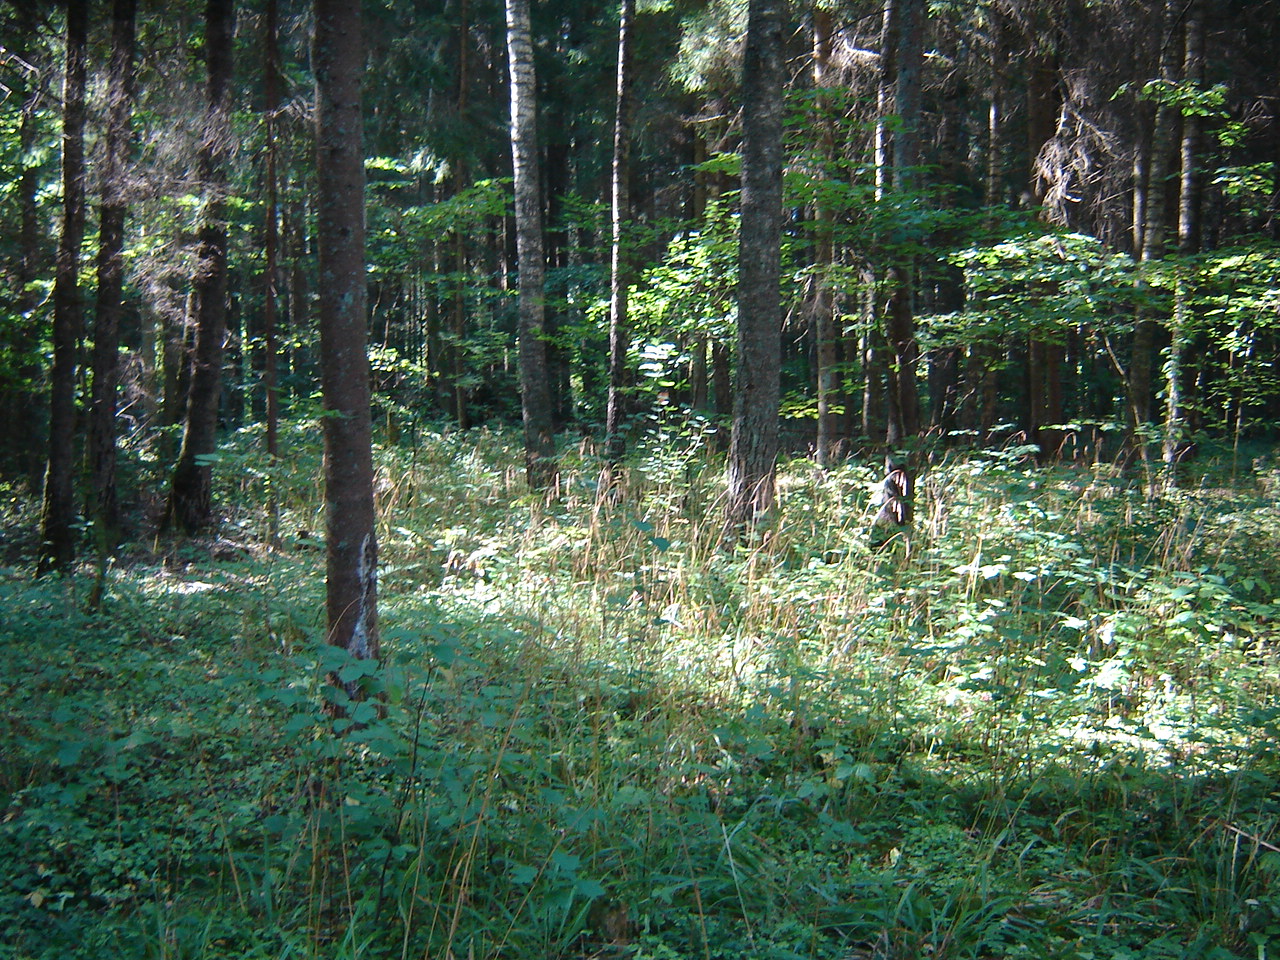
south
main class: Woodland
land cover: Spruce dominated mixed woodland
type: hemiboreal forest and nemoral coniferous forest and mixed broadleaved-coniferous forest
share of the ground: > 75 %
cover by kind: coniferous forest trees 55 %, broadleaved forest trees 25 %, herbaceous plants 10 %, shrubs 5 %, lichens and mosses 5 %
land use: Forestry
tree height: > 5 m
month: August
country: LT
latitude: 54.8188
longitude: 25.3270
